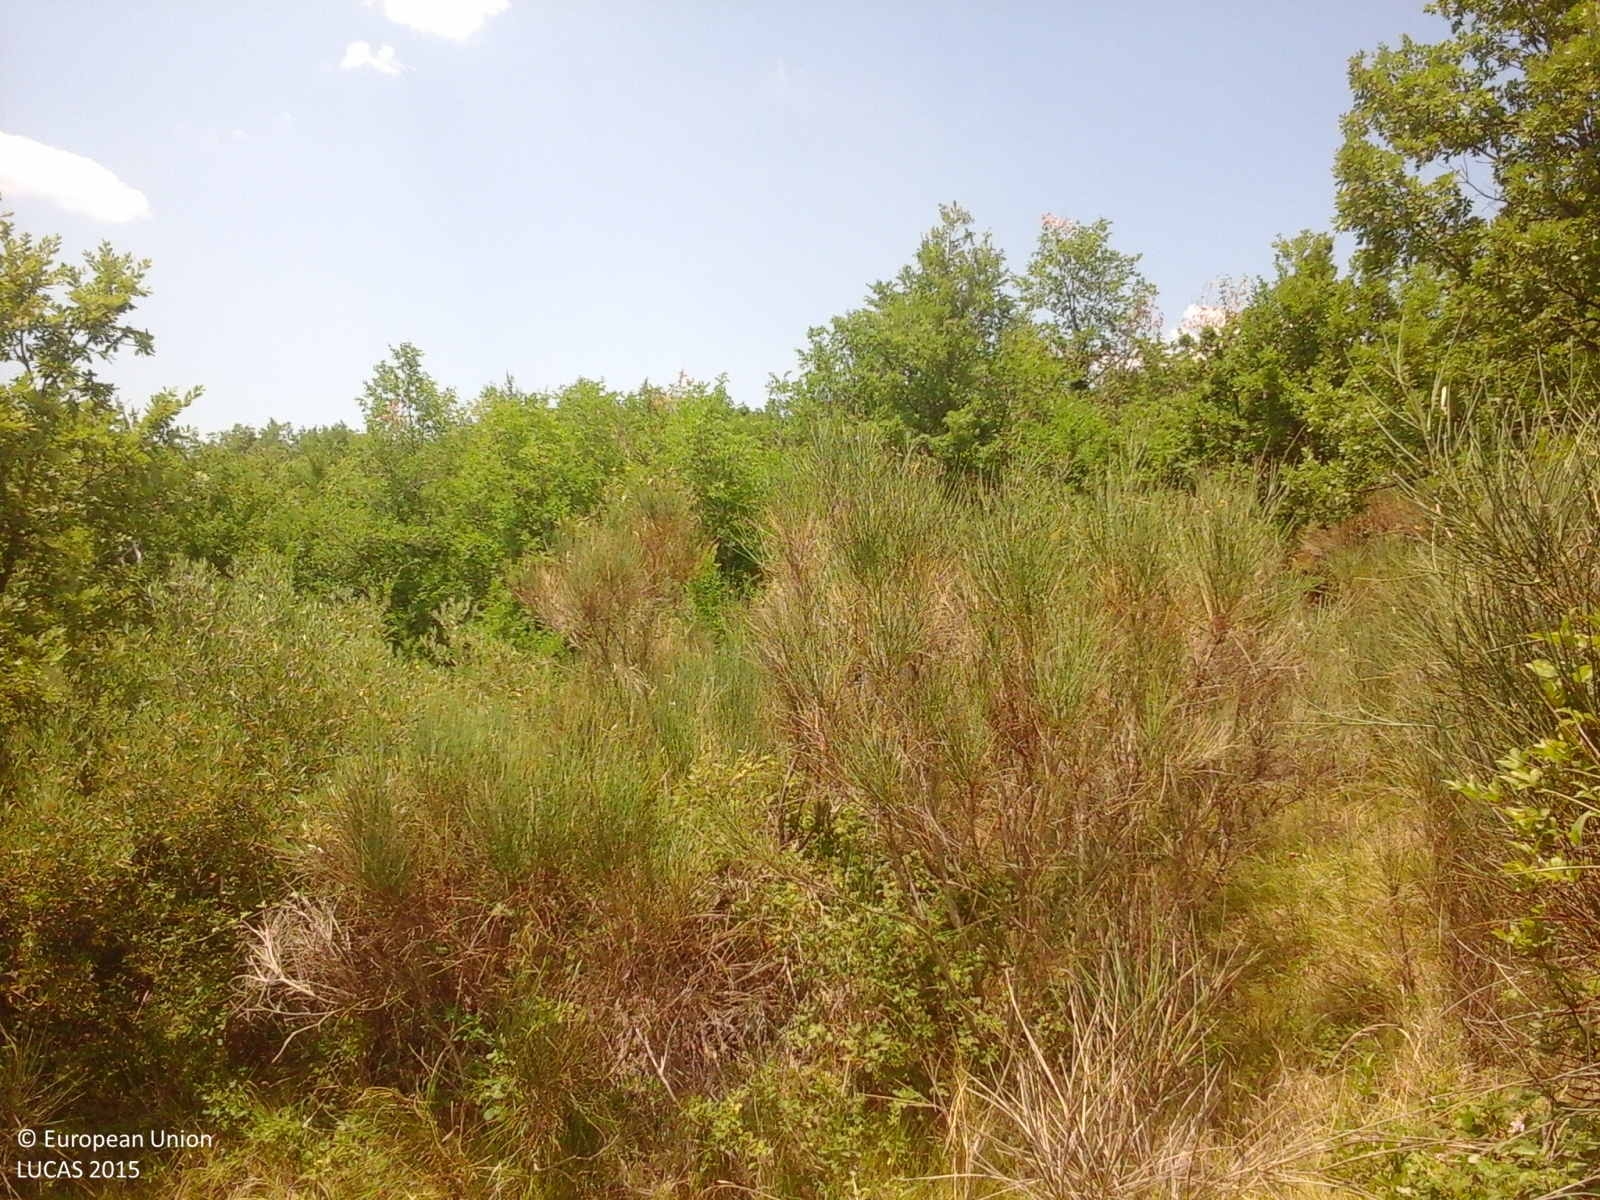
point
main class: Woodland
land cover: Broadleaved woodland
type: thermophilous deciduous forest
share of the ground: > 75 %
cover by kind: broadleaved forest trees 80 %, shrubs 15 %, herbaceous plants 5 %
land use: Forestry
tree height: > 5 m
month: July
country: IT
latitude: 40.8613
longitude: 15.0696
